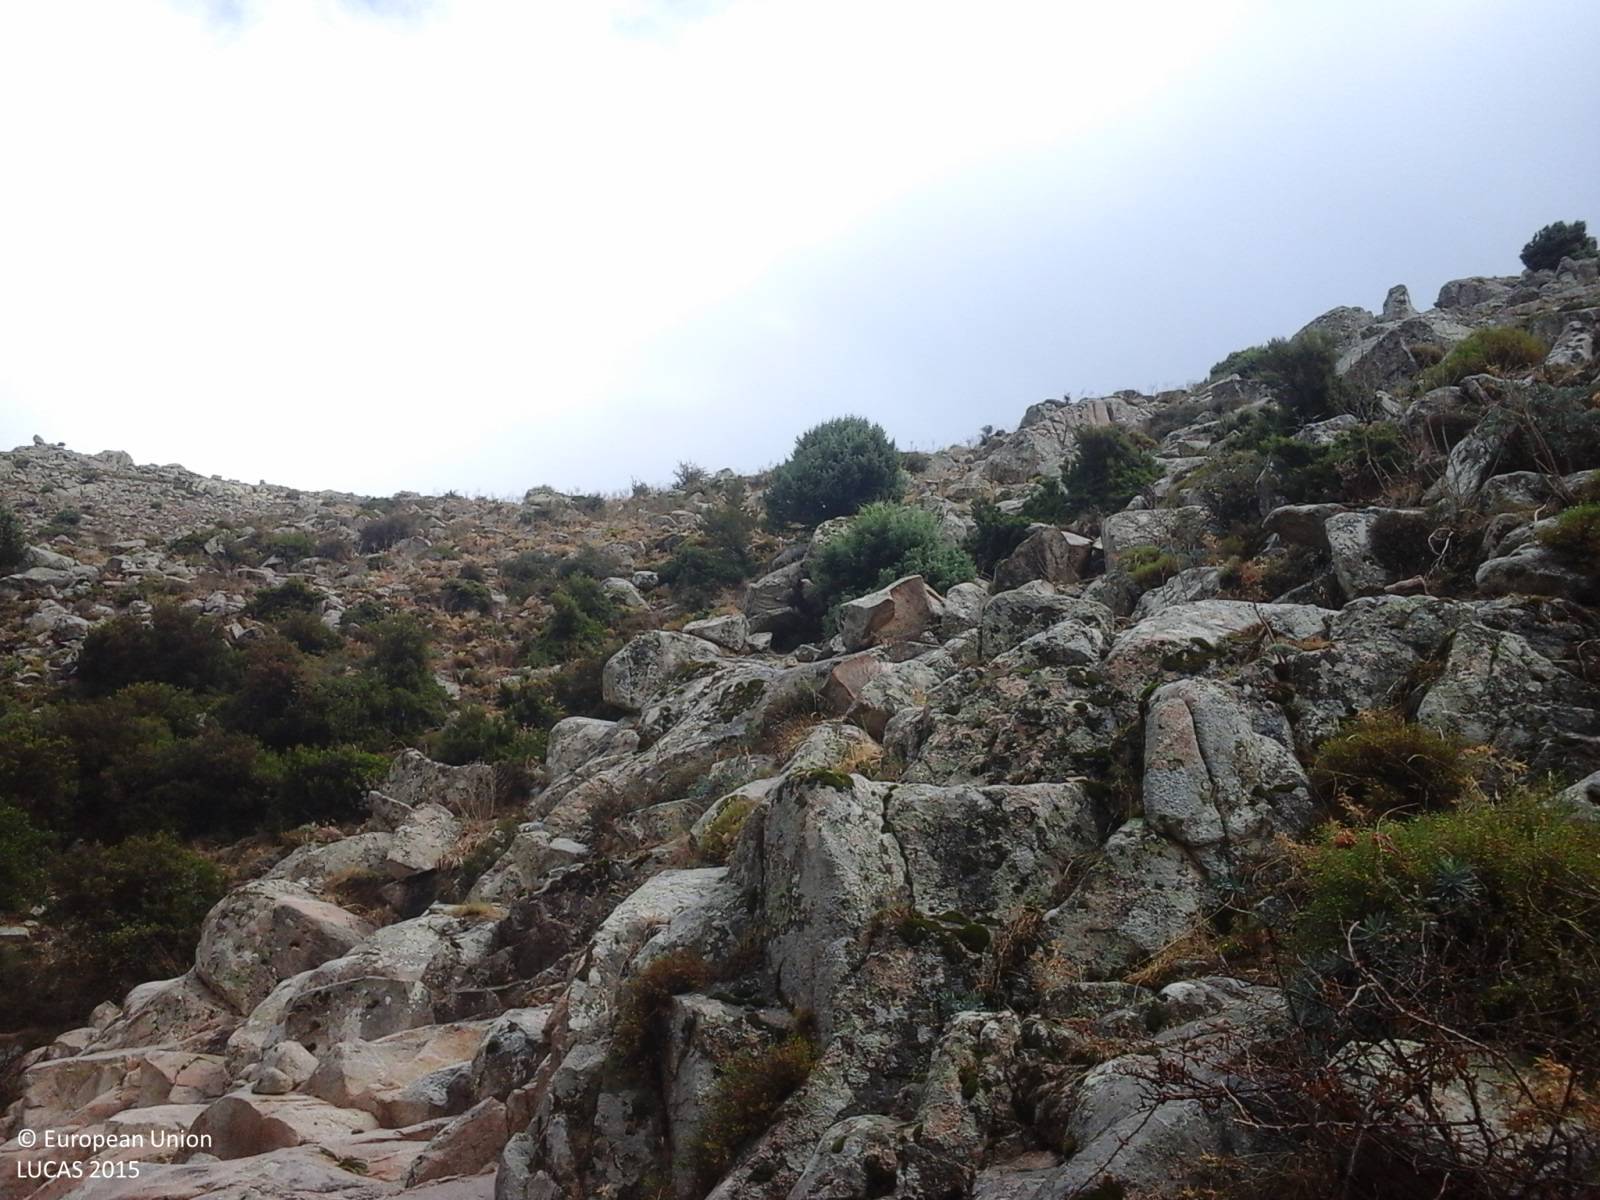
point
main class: Shrubland
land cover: Shrubland without tree cover
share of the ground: > 75 %
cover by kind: consolidated bare surface 40 %, shrubs 25 %, unconsolidated bare surface 20 %, herbaceous plants 15 %
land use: Semi-natural and natural areas not in use
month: September
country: IT
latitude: 39.9392
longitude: 9.3366
